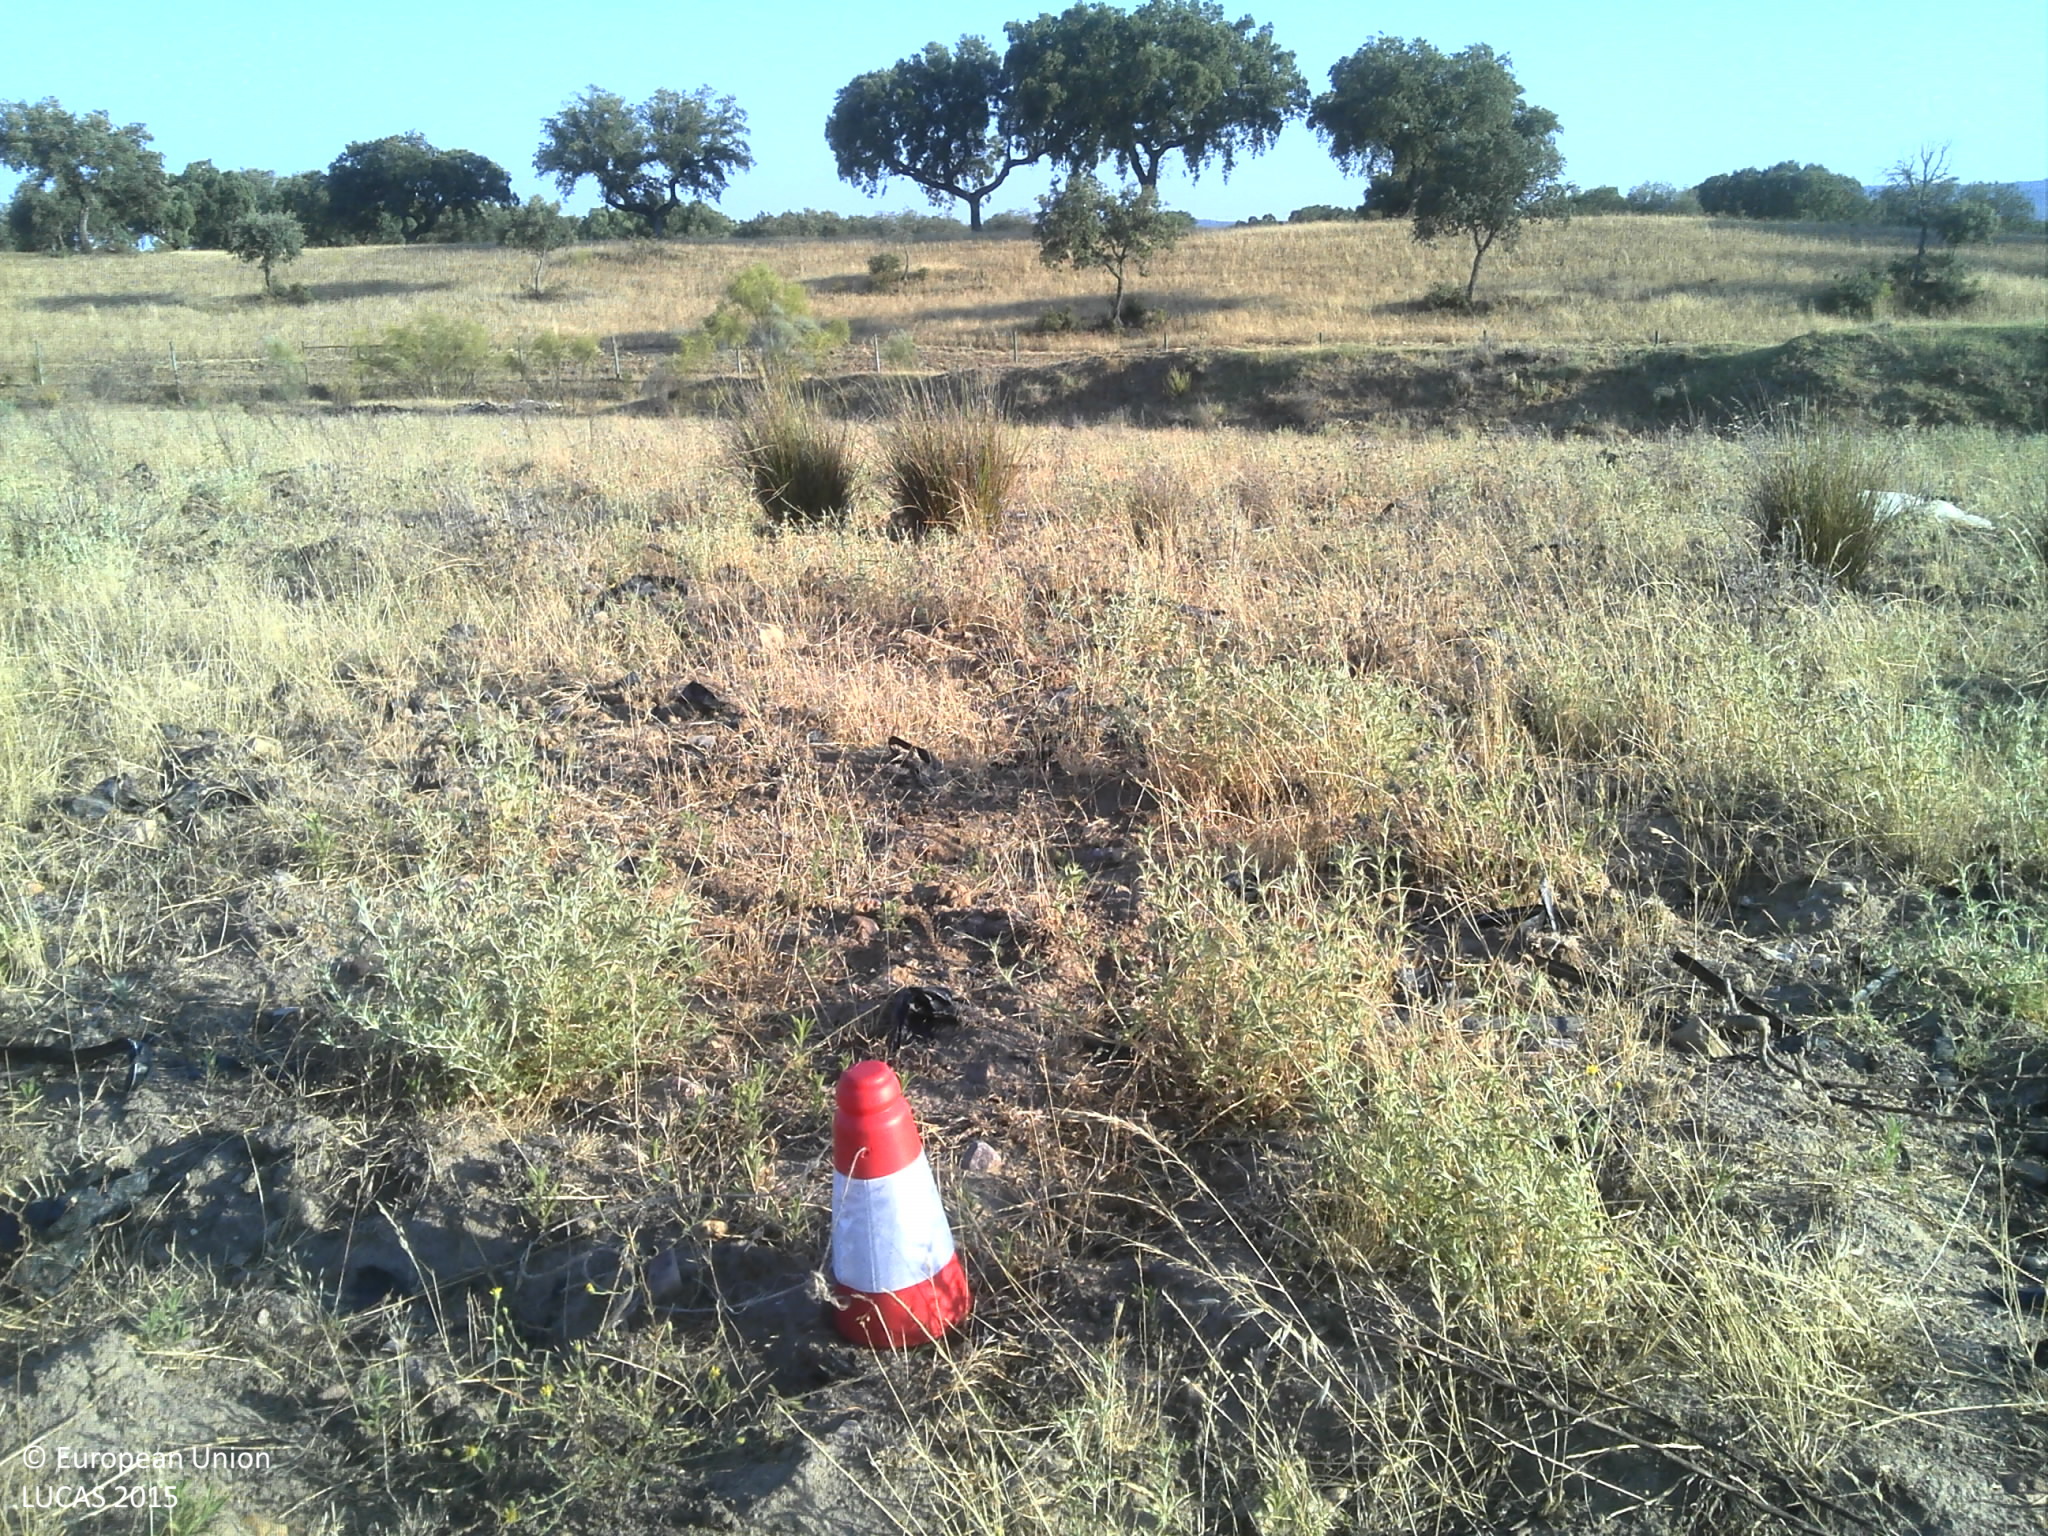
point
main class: Grassland
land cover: Grassland with sparse tree/shrub cover
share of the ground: 50 - 75 %
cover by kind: herbaceous plants 75 %, unconsolidated bare surface 15 %, broadleaved forest trees 5 %, shrubs 5 %
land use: Agriculture (excluding fallow land and kitchen gardens)
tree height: > 5 m
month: June
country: PT
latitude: 39.8102
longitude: -7.2763
